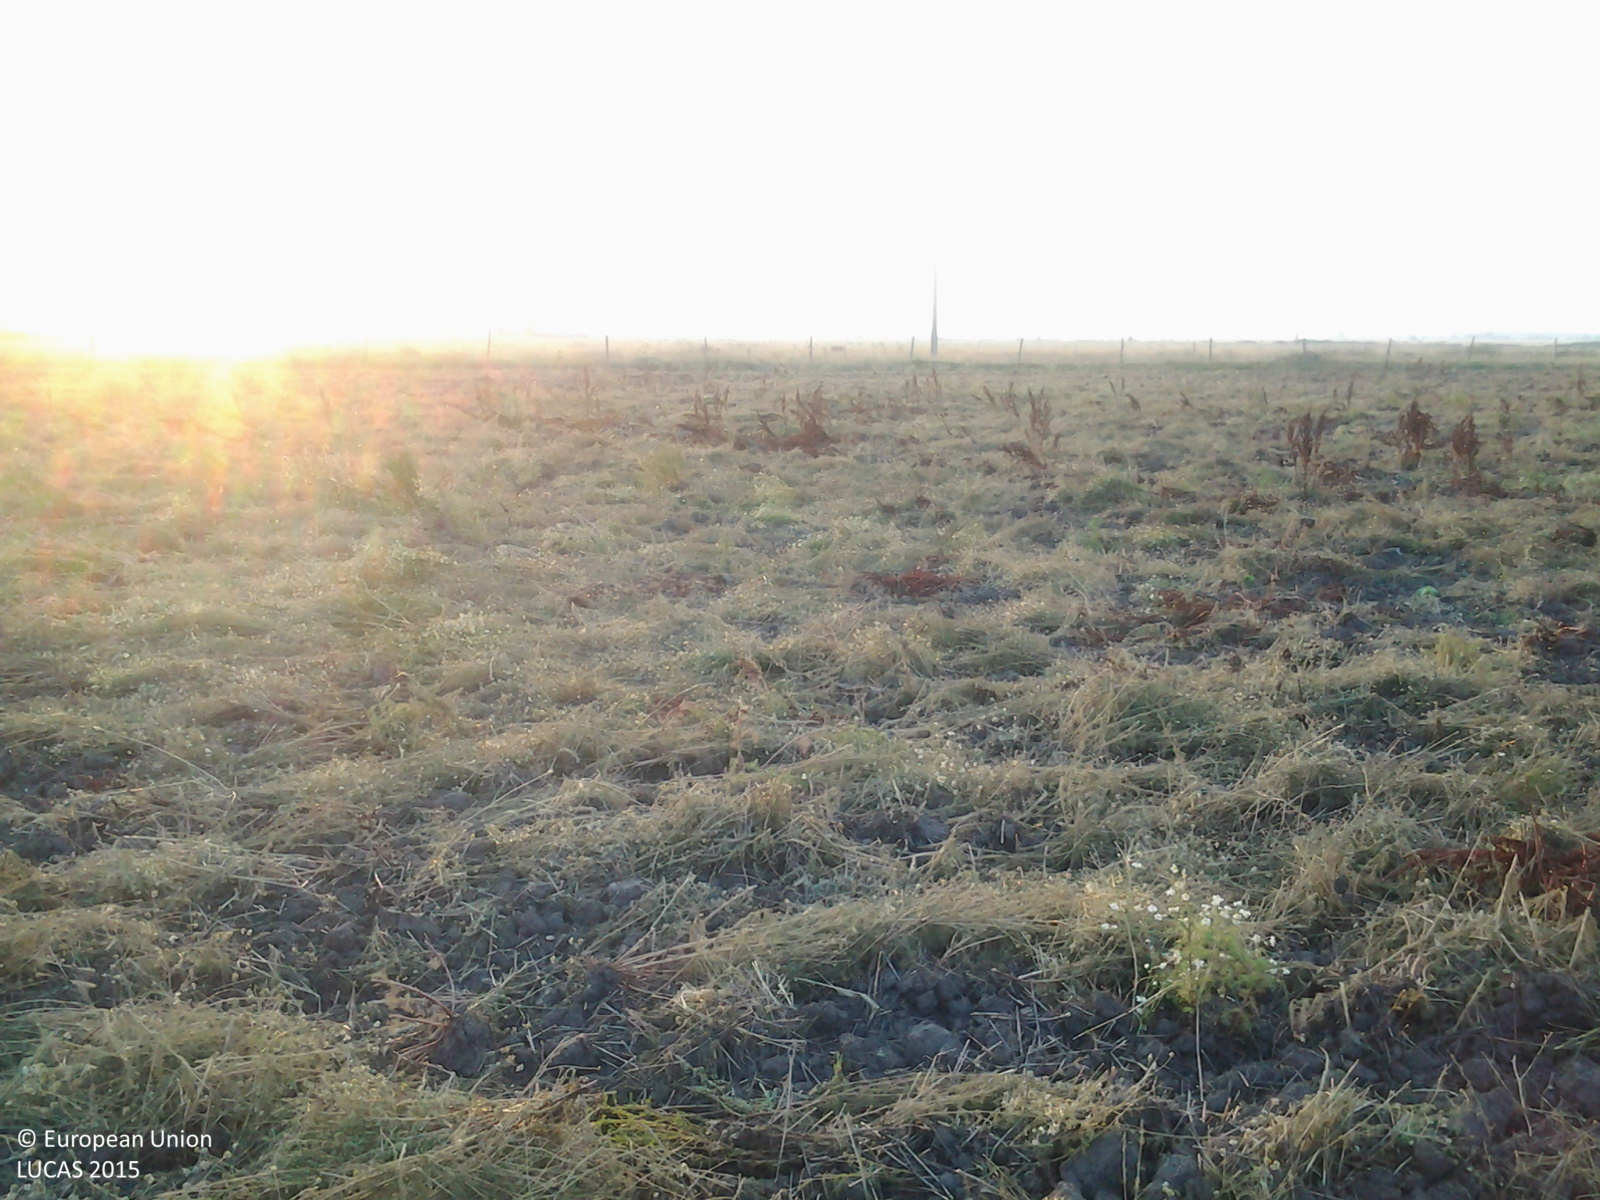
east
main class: Cropland
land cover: Common wheat
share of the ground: < 10 %
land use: Agriculture (excluding fallow land and kitchen gardens)
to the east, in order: Common wheat; Grass margins; Tracks; Grass margins; Fences; Grassland without tree/shrub cover; Electric lines; Grassland without tree/shrub cover; Fences; Grassland without tree/shrub cover
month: July
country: HU
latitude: 47.0853
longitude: 20.6874
